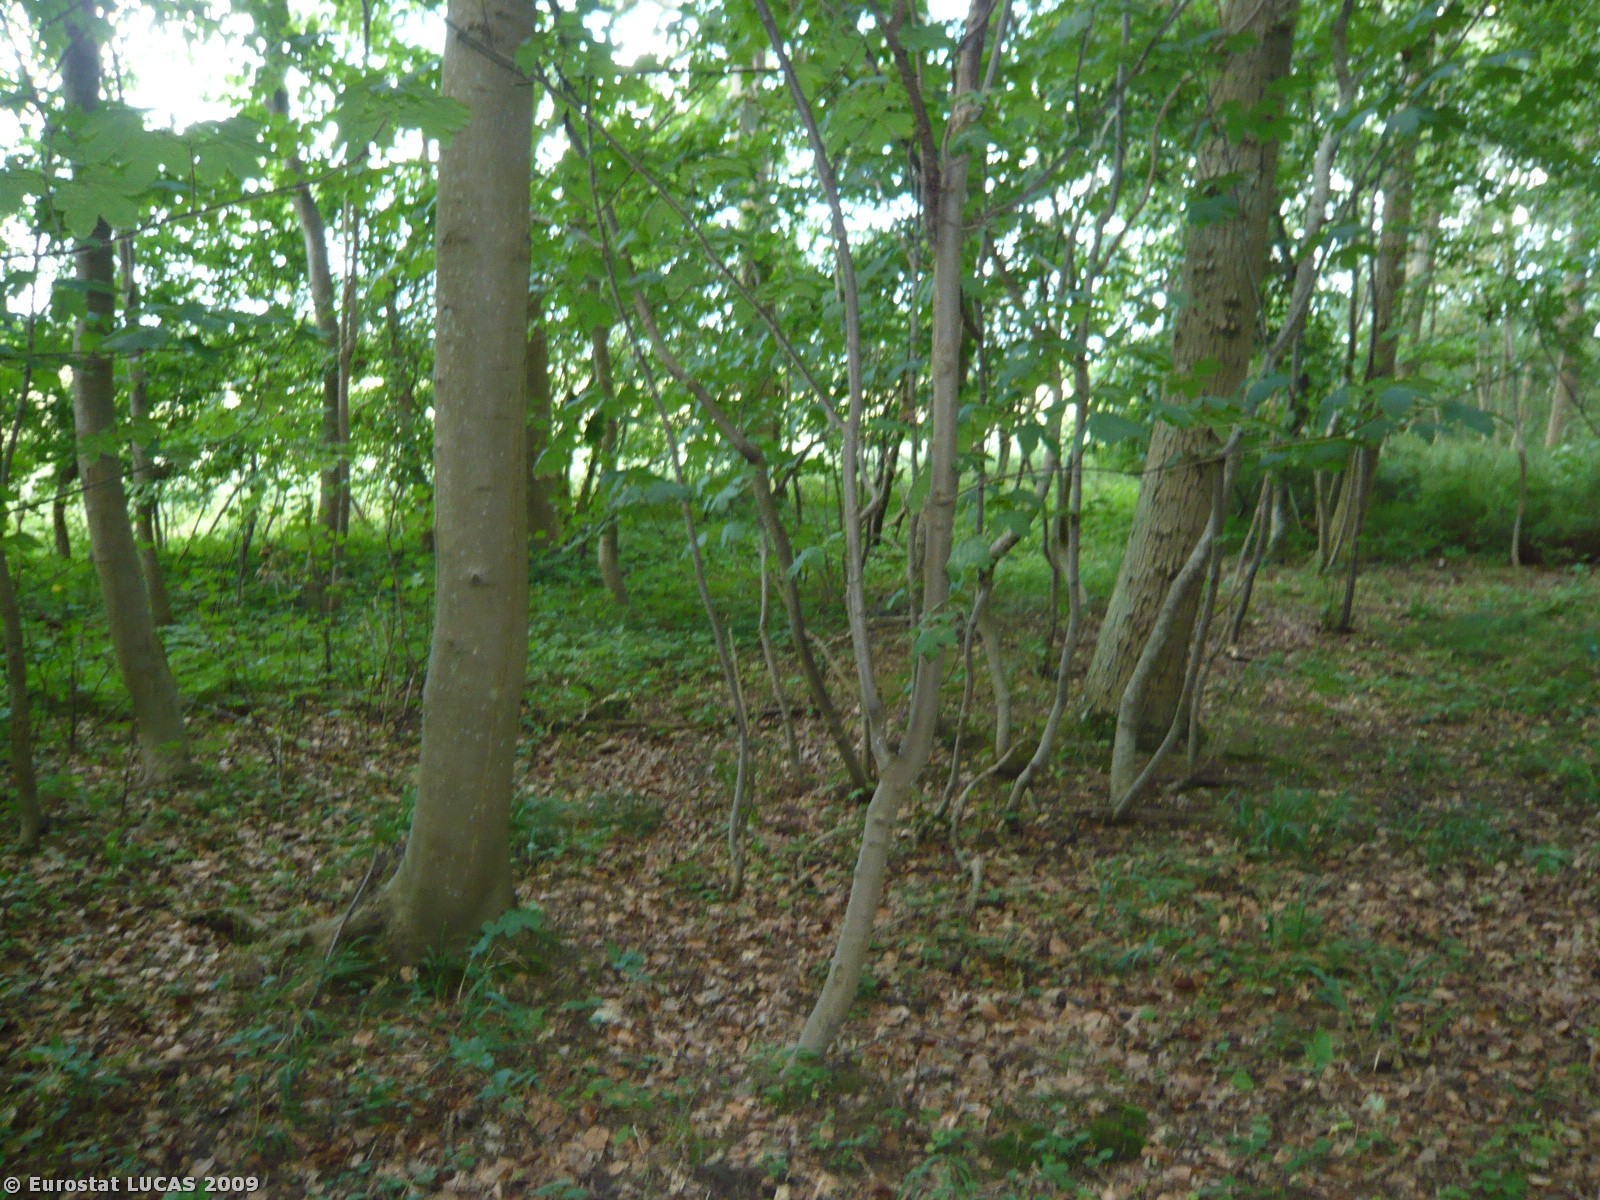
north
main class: Woodland
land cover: Broadleaved woodland
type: mesophytic deciduous forest
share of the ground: > 75 %
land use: Forestry
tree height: > 5 m
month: July
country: DK
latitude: 55.3774
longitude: 10.6149
